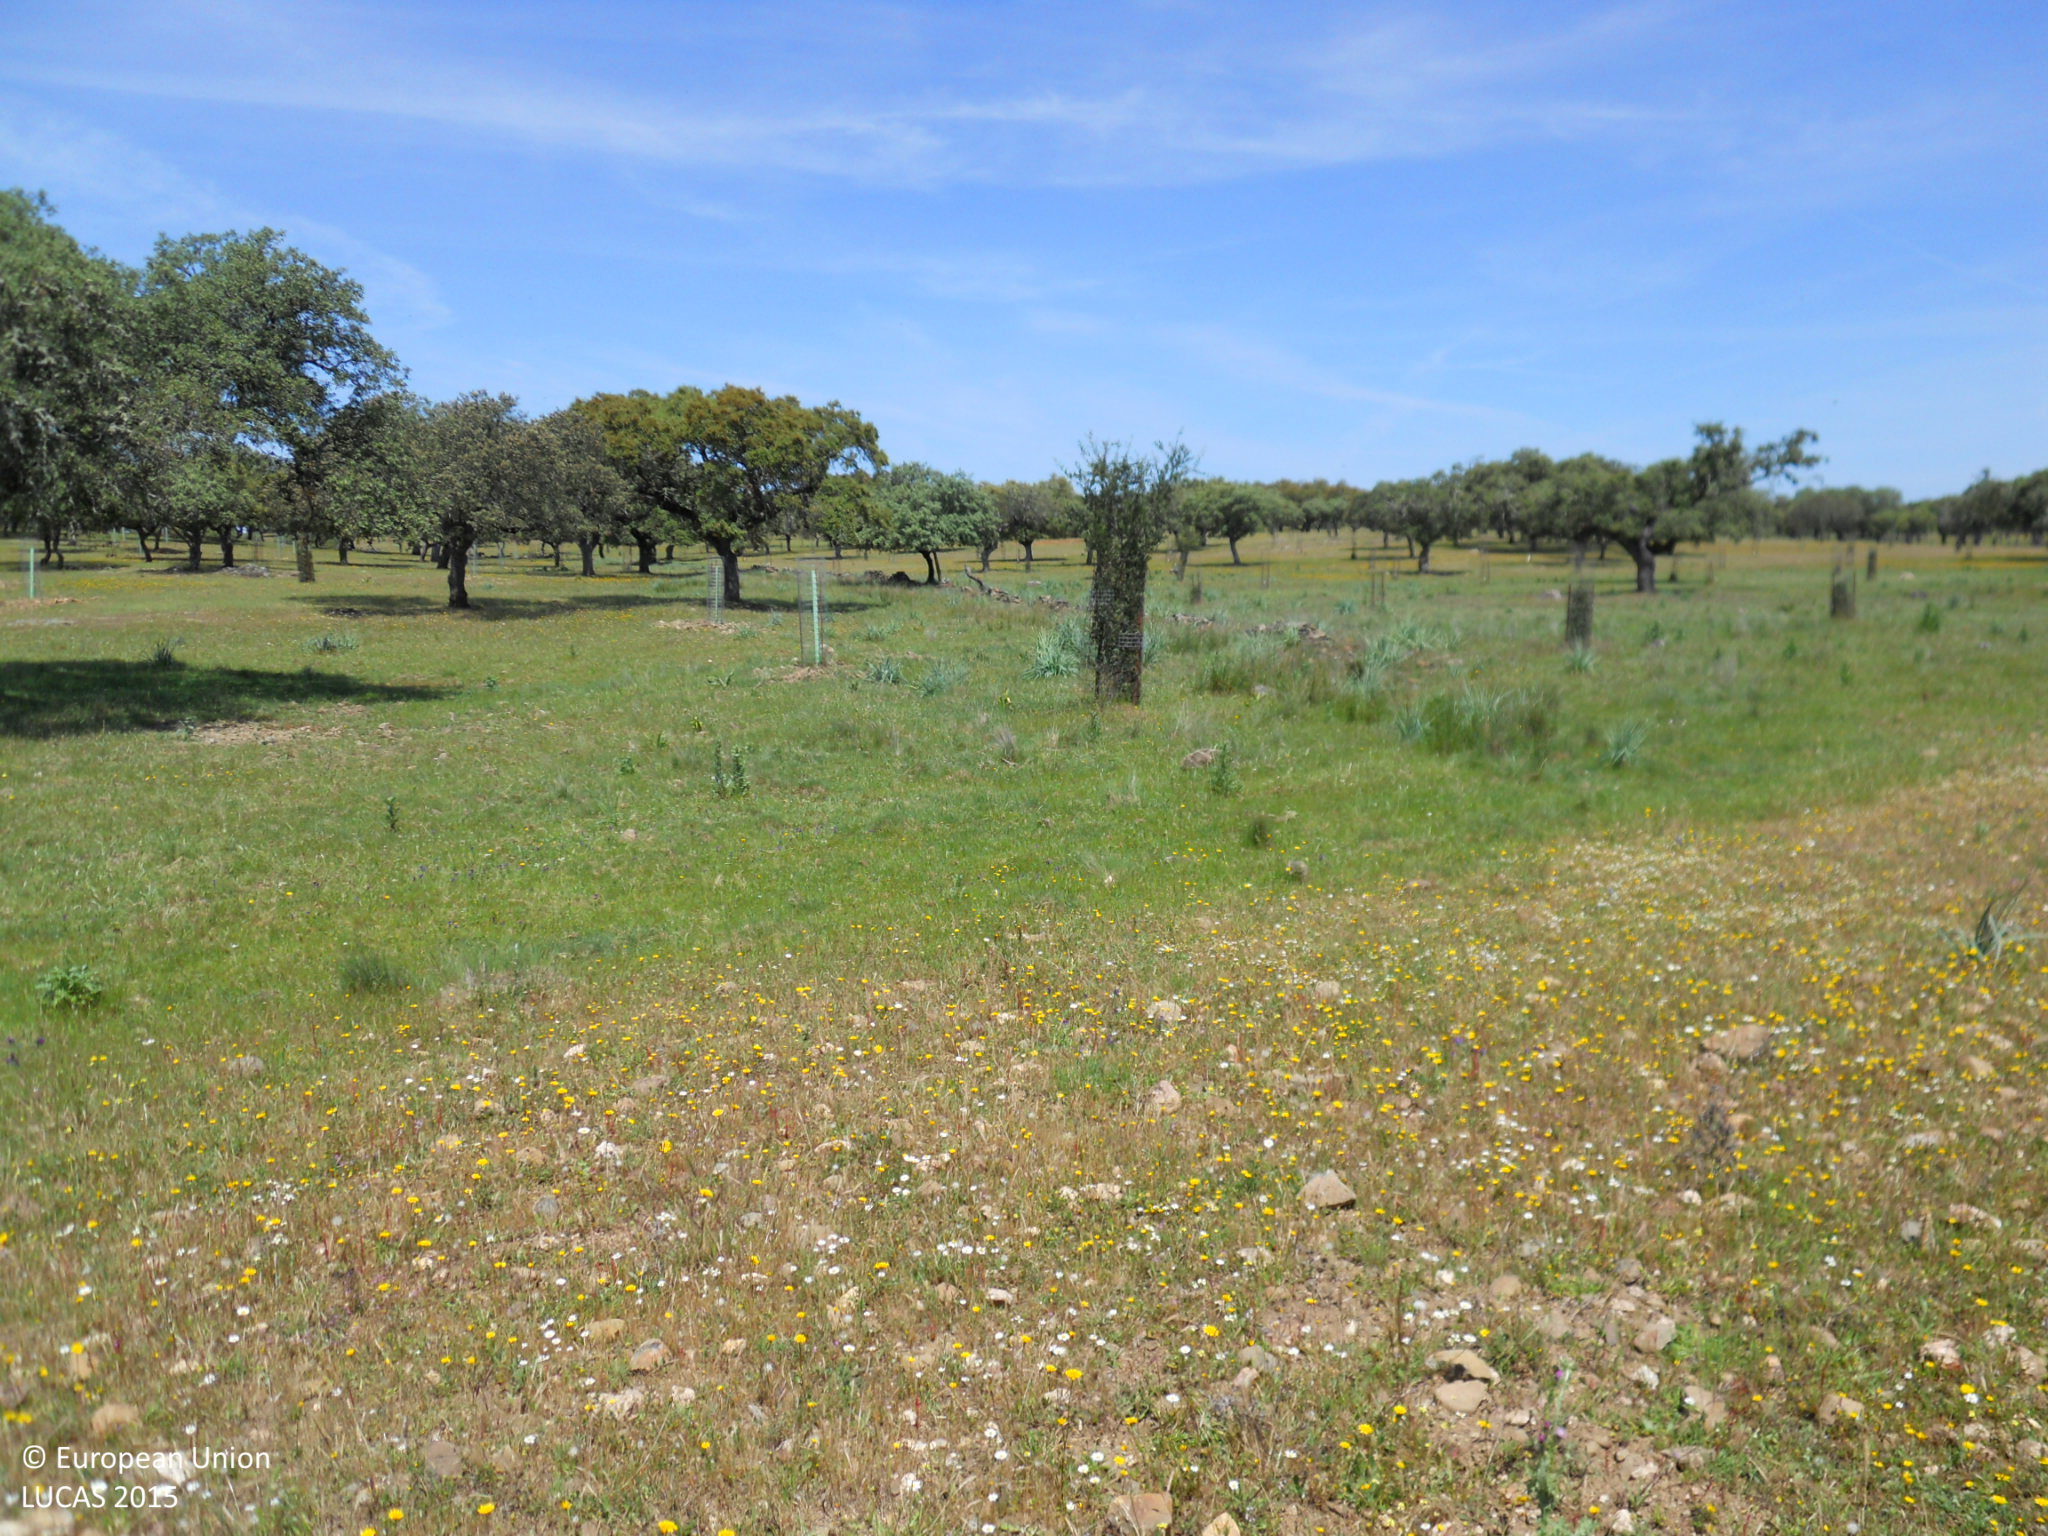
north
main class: Grassland
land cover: Grassland with sparse tree/shrub cover
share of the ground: > 75 %
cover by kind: herbaceous plants 90 %, broadleaved forest trees 5 %, shrubs 5 %
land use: Agriculture (excluding fallow land and kitchen gardens)
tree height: < 5 m
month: April
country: ES
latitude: 39.1680
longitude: -6.8433
